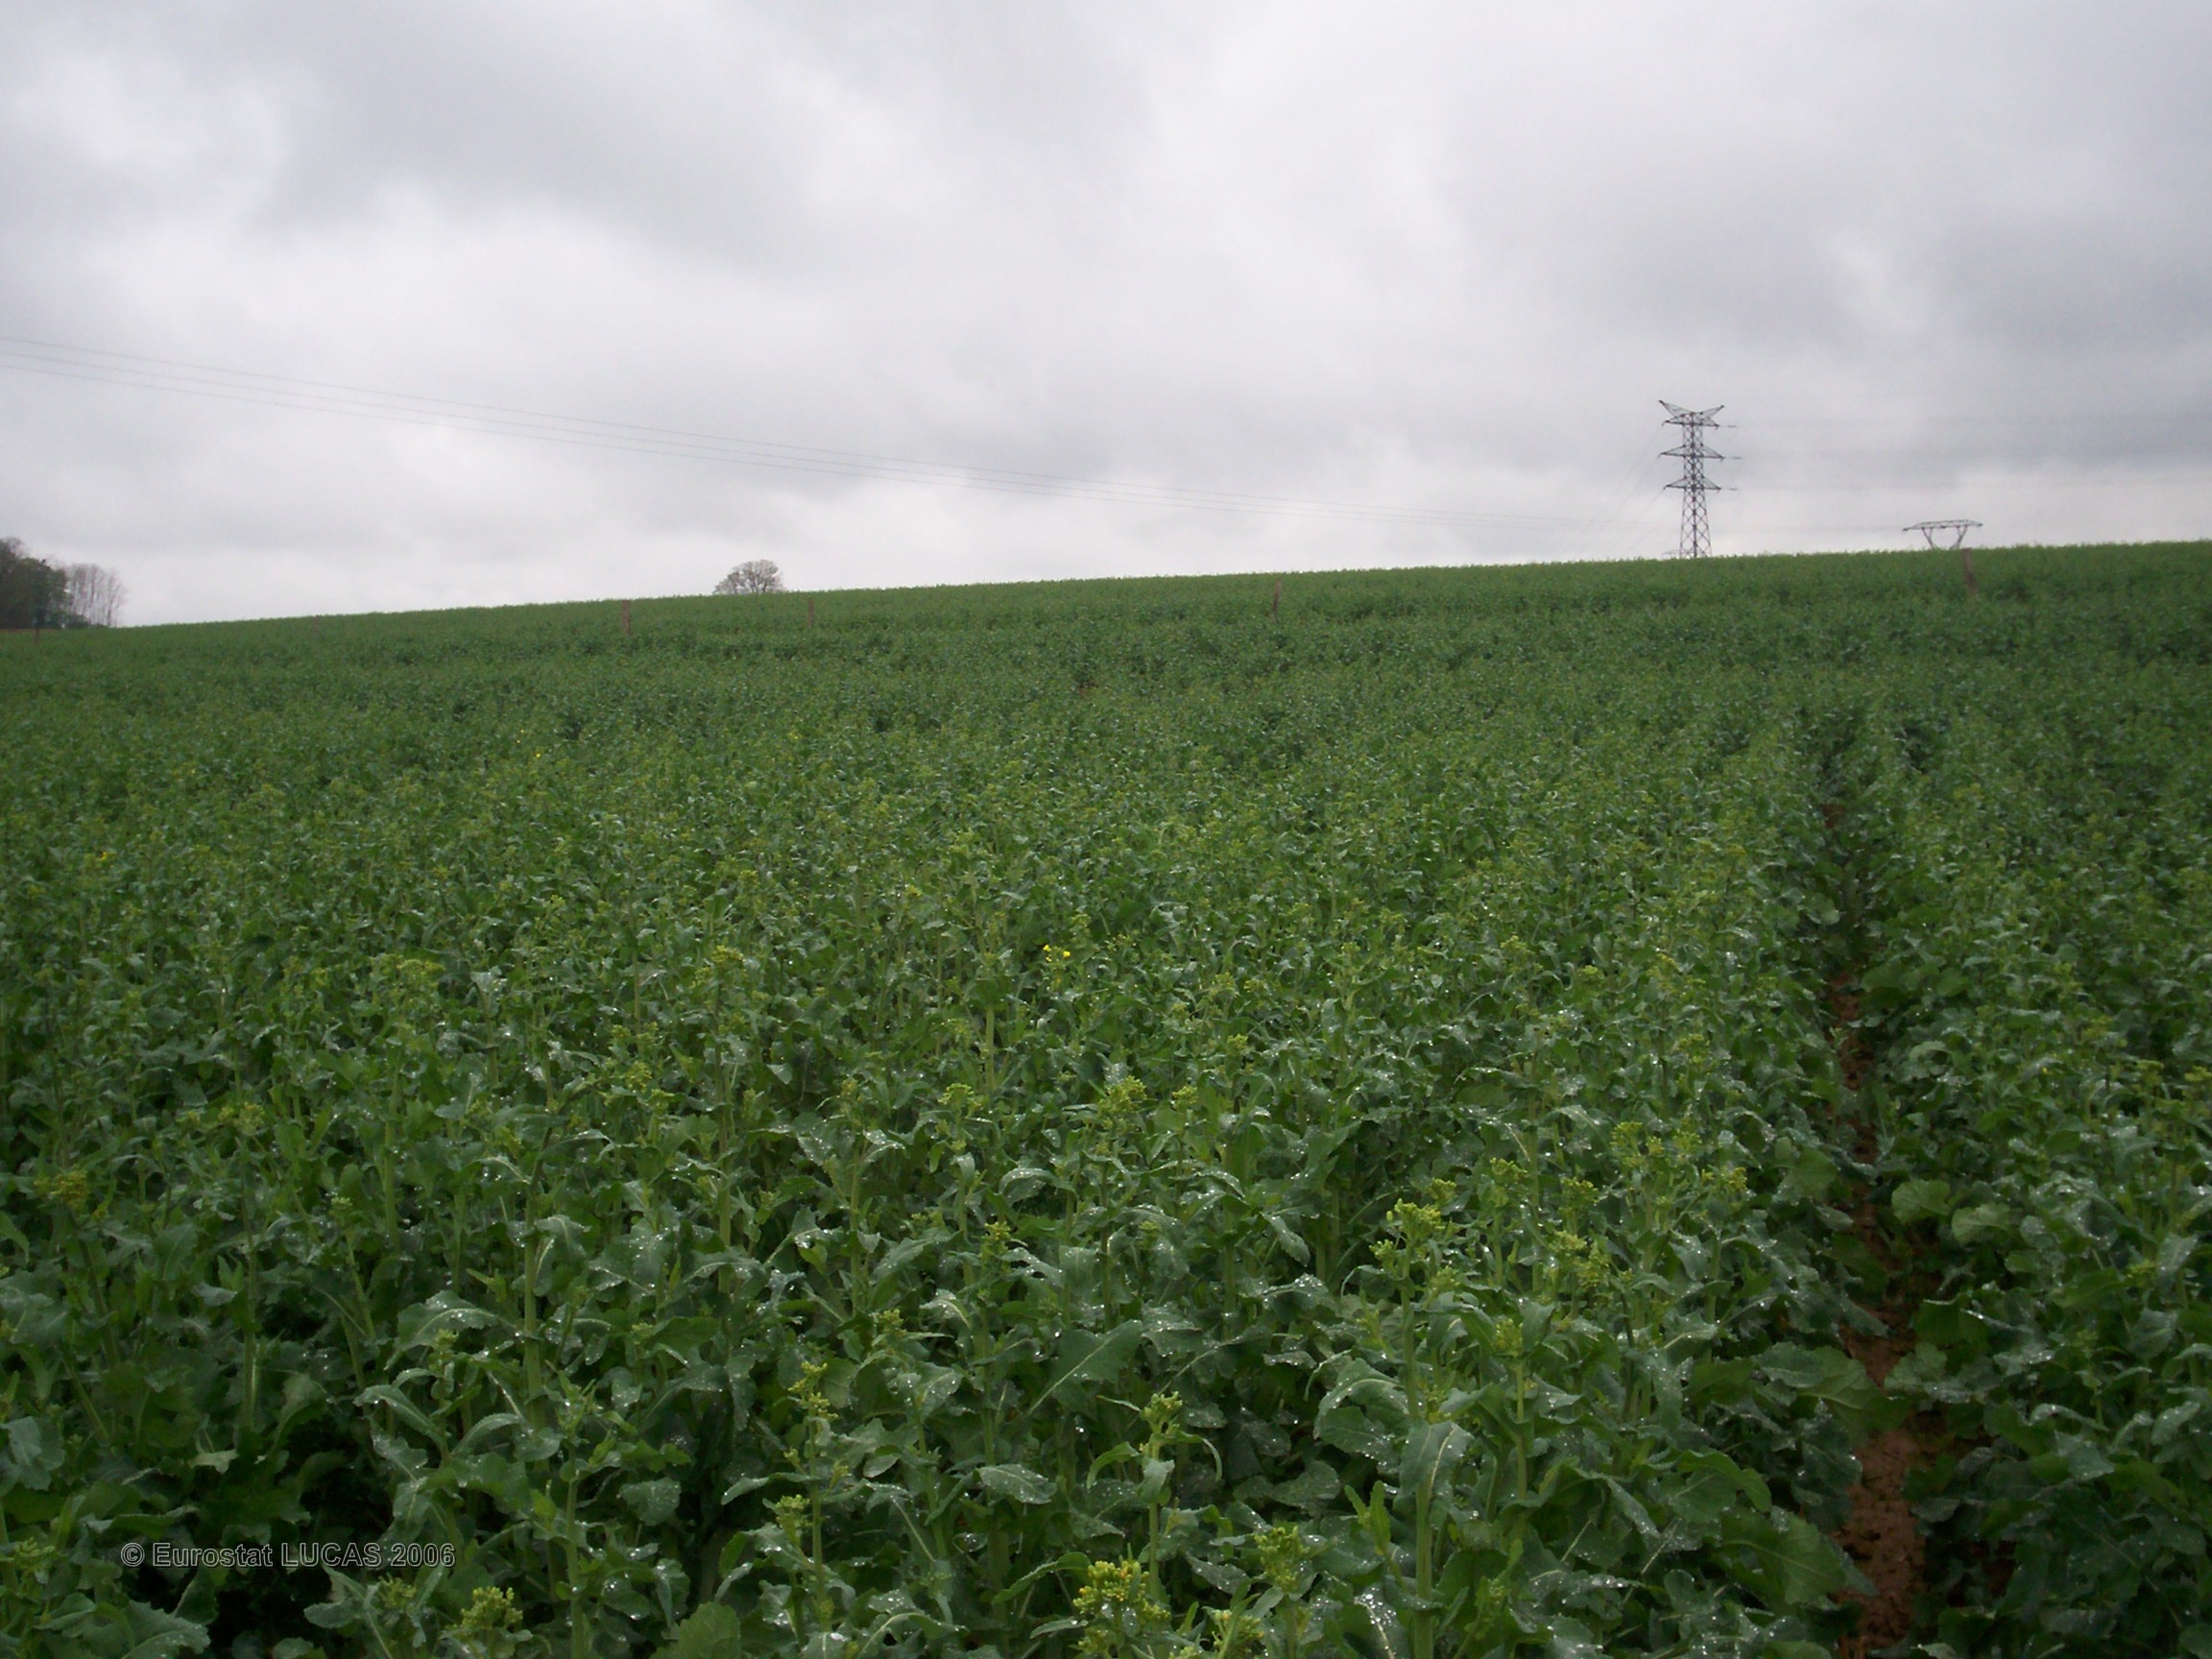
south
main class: Cropland
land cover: Rape and turnip rape
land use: Agriculture (excluding fallow land and kitchen gardens)
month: April
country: FR
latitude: 47.7031
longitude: 6.0697
